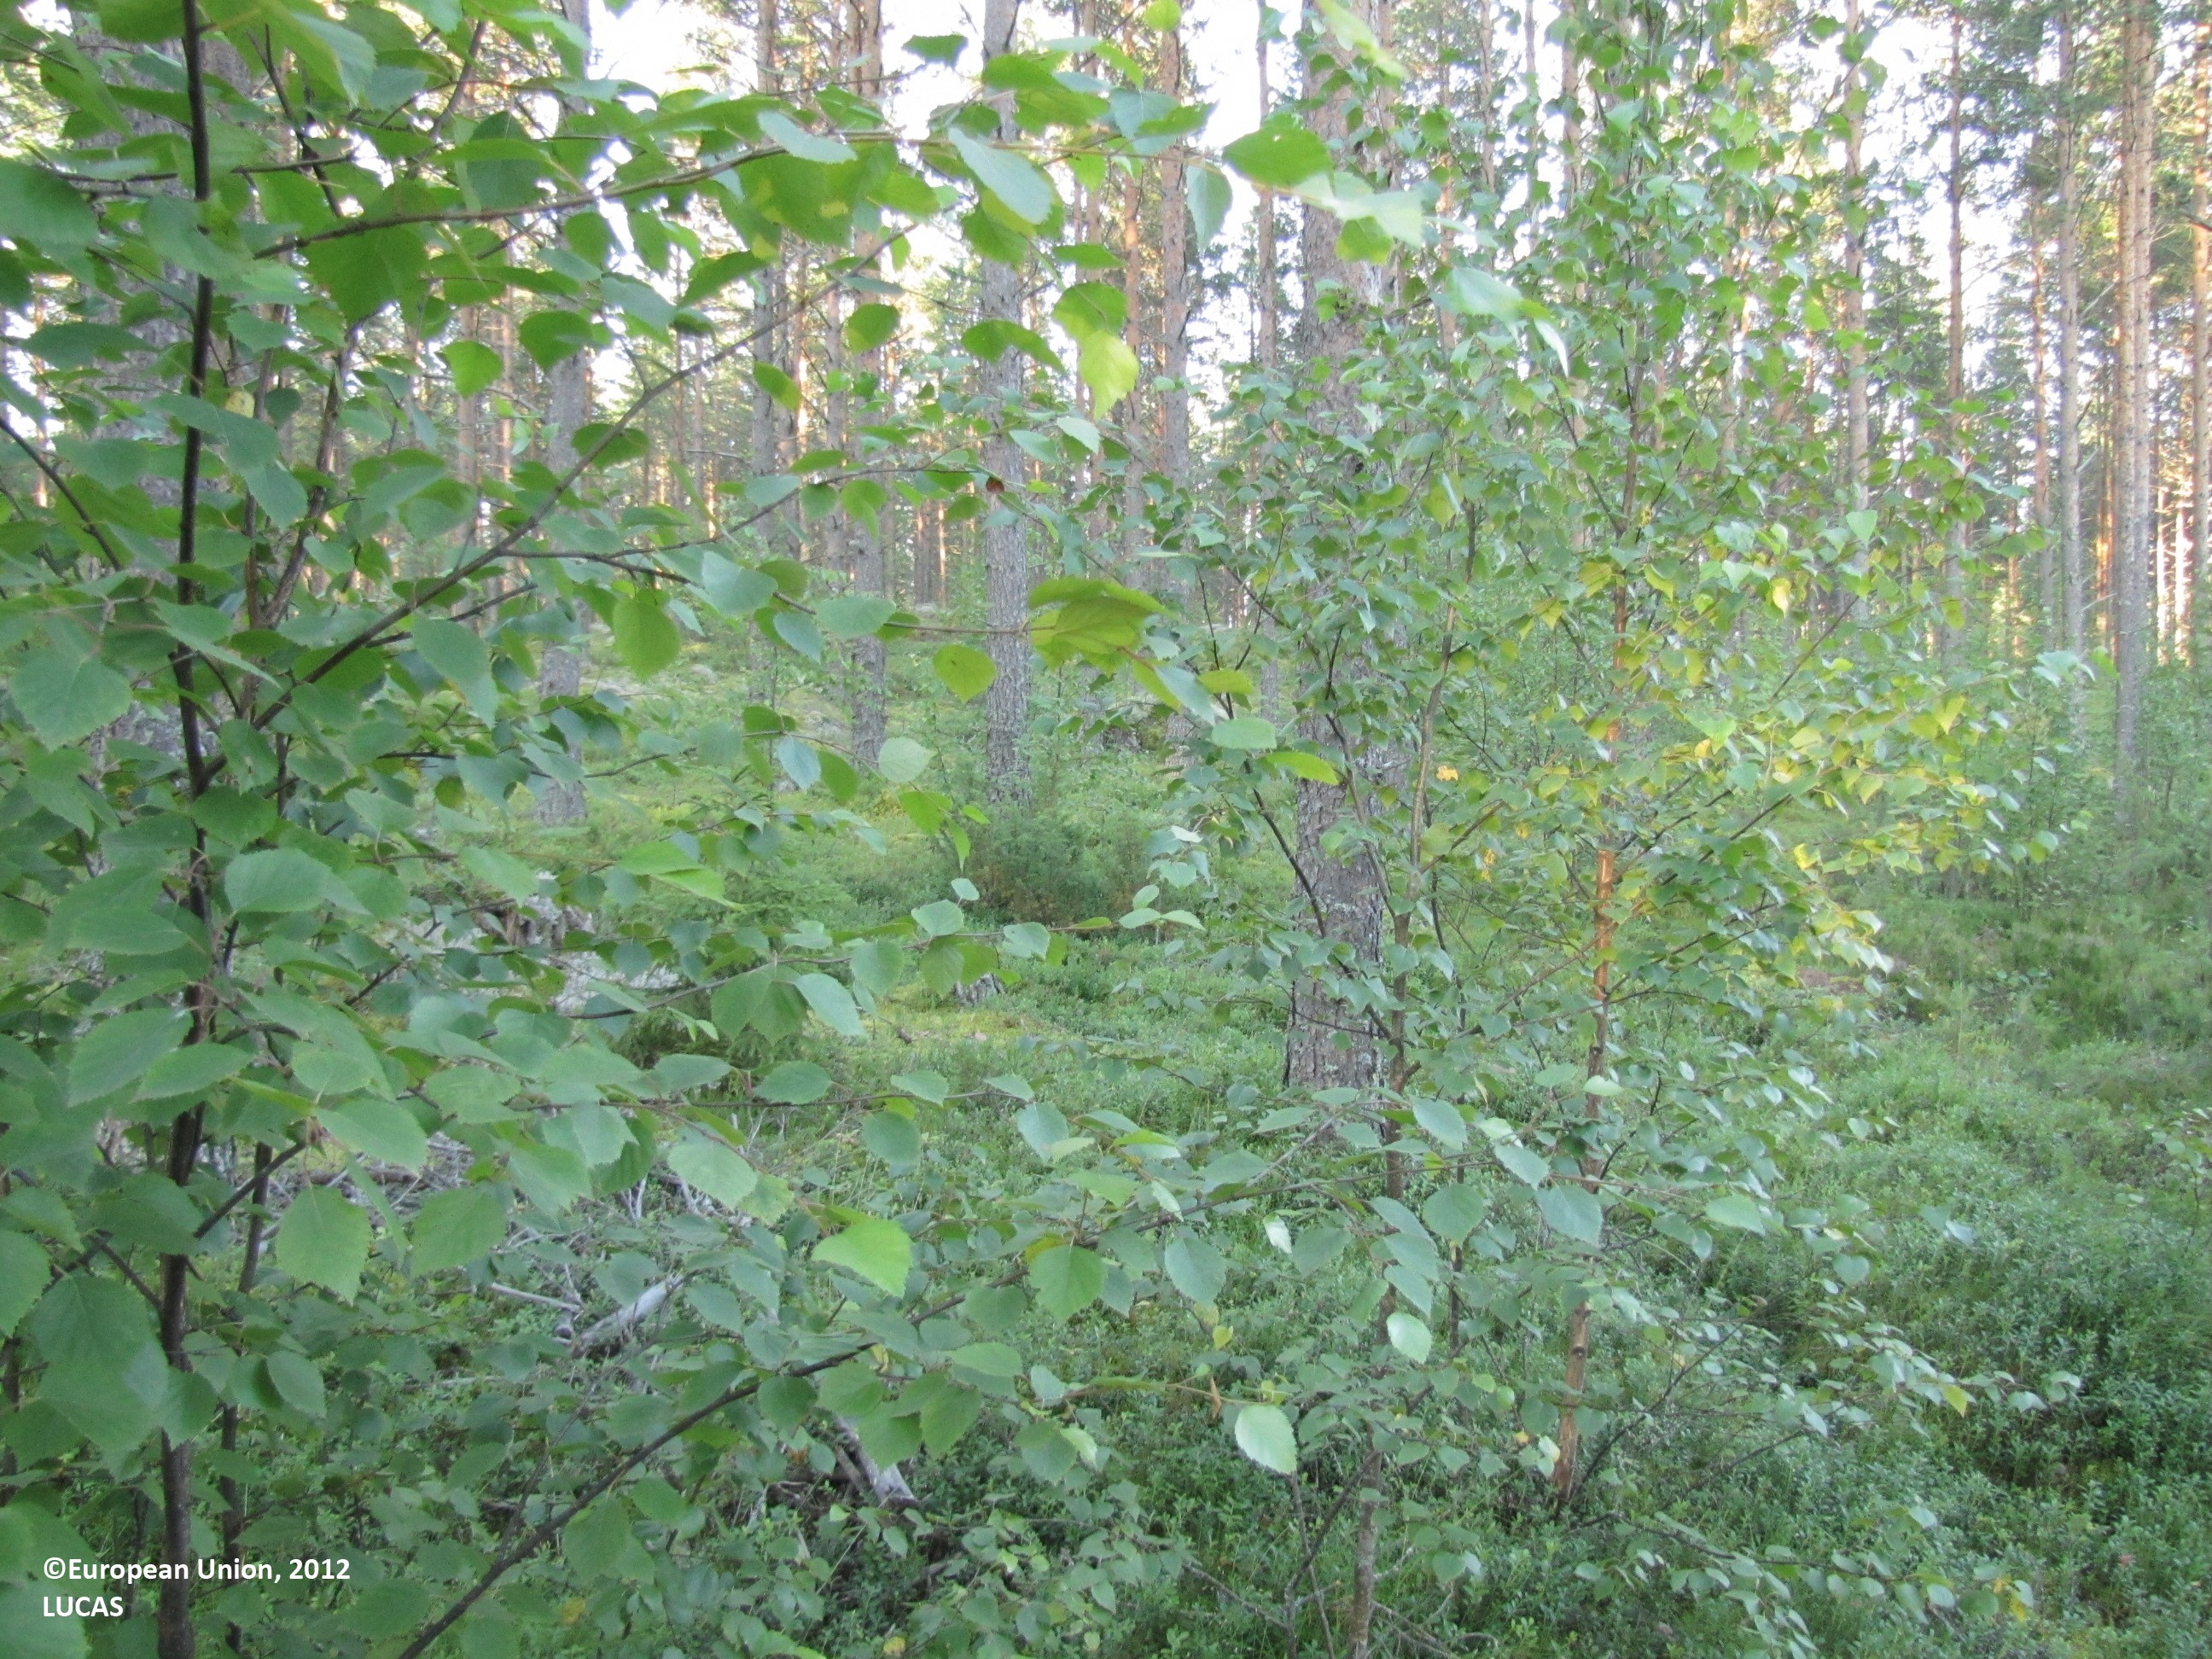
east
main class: Woodland
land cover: Pine dominated coniferous woodland
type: boreal forest
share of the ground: 50 - 75 %
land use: Forestry
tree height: > 5 m
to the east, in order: Pine dominated coniferous woodland
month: July
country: FI
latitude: 62.0800
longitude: 23.0274
